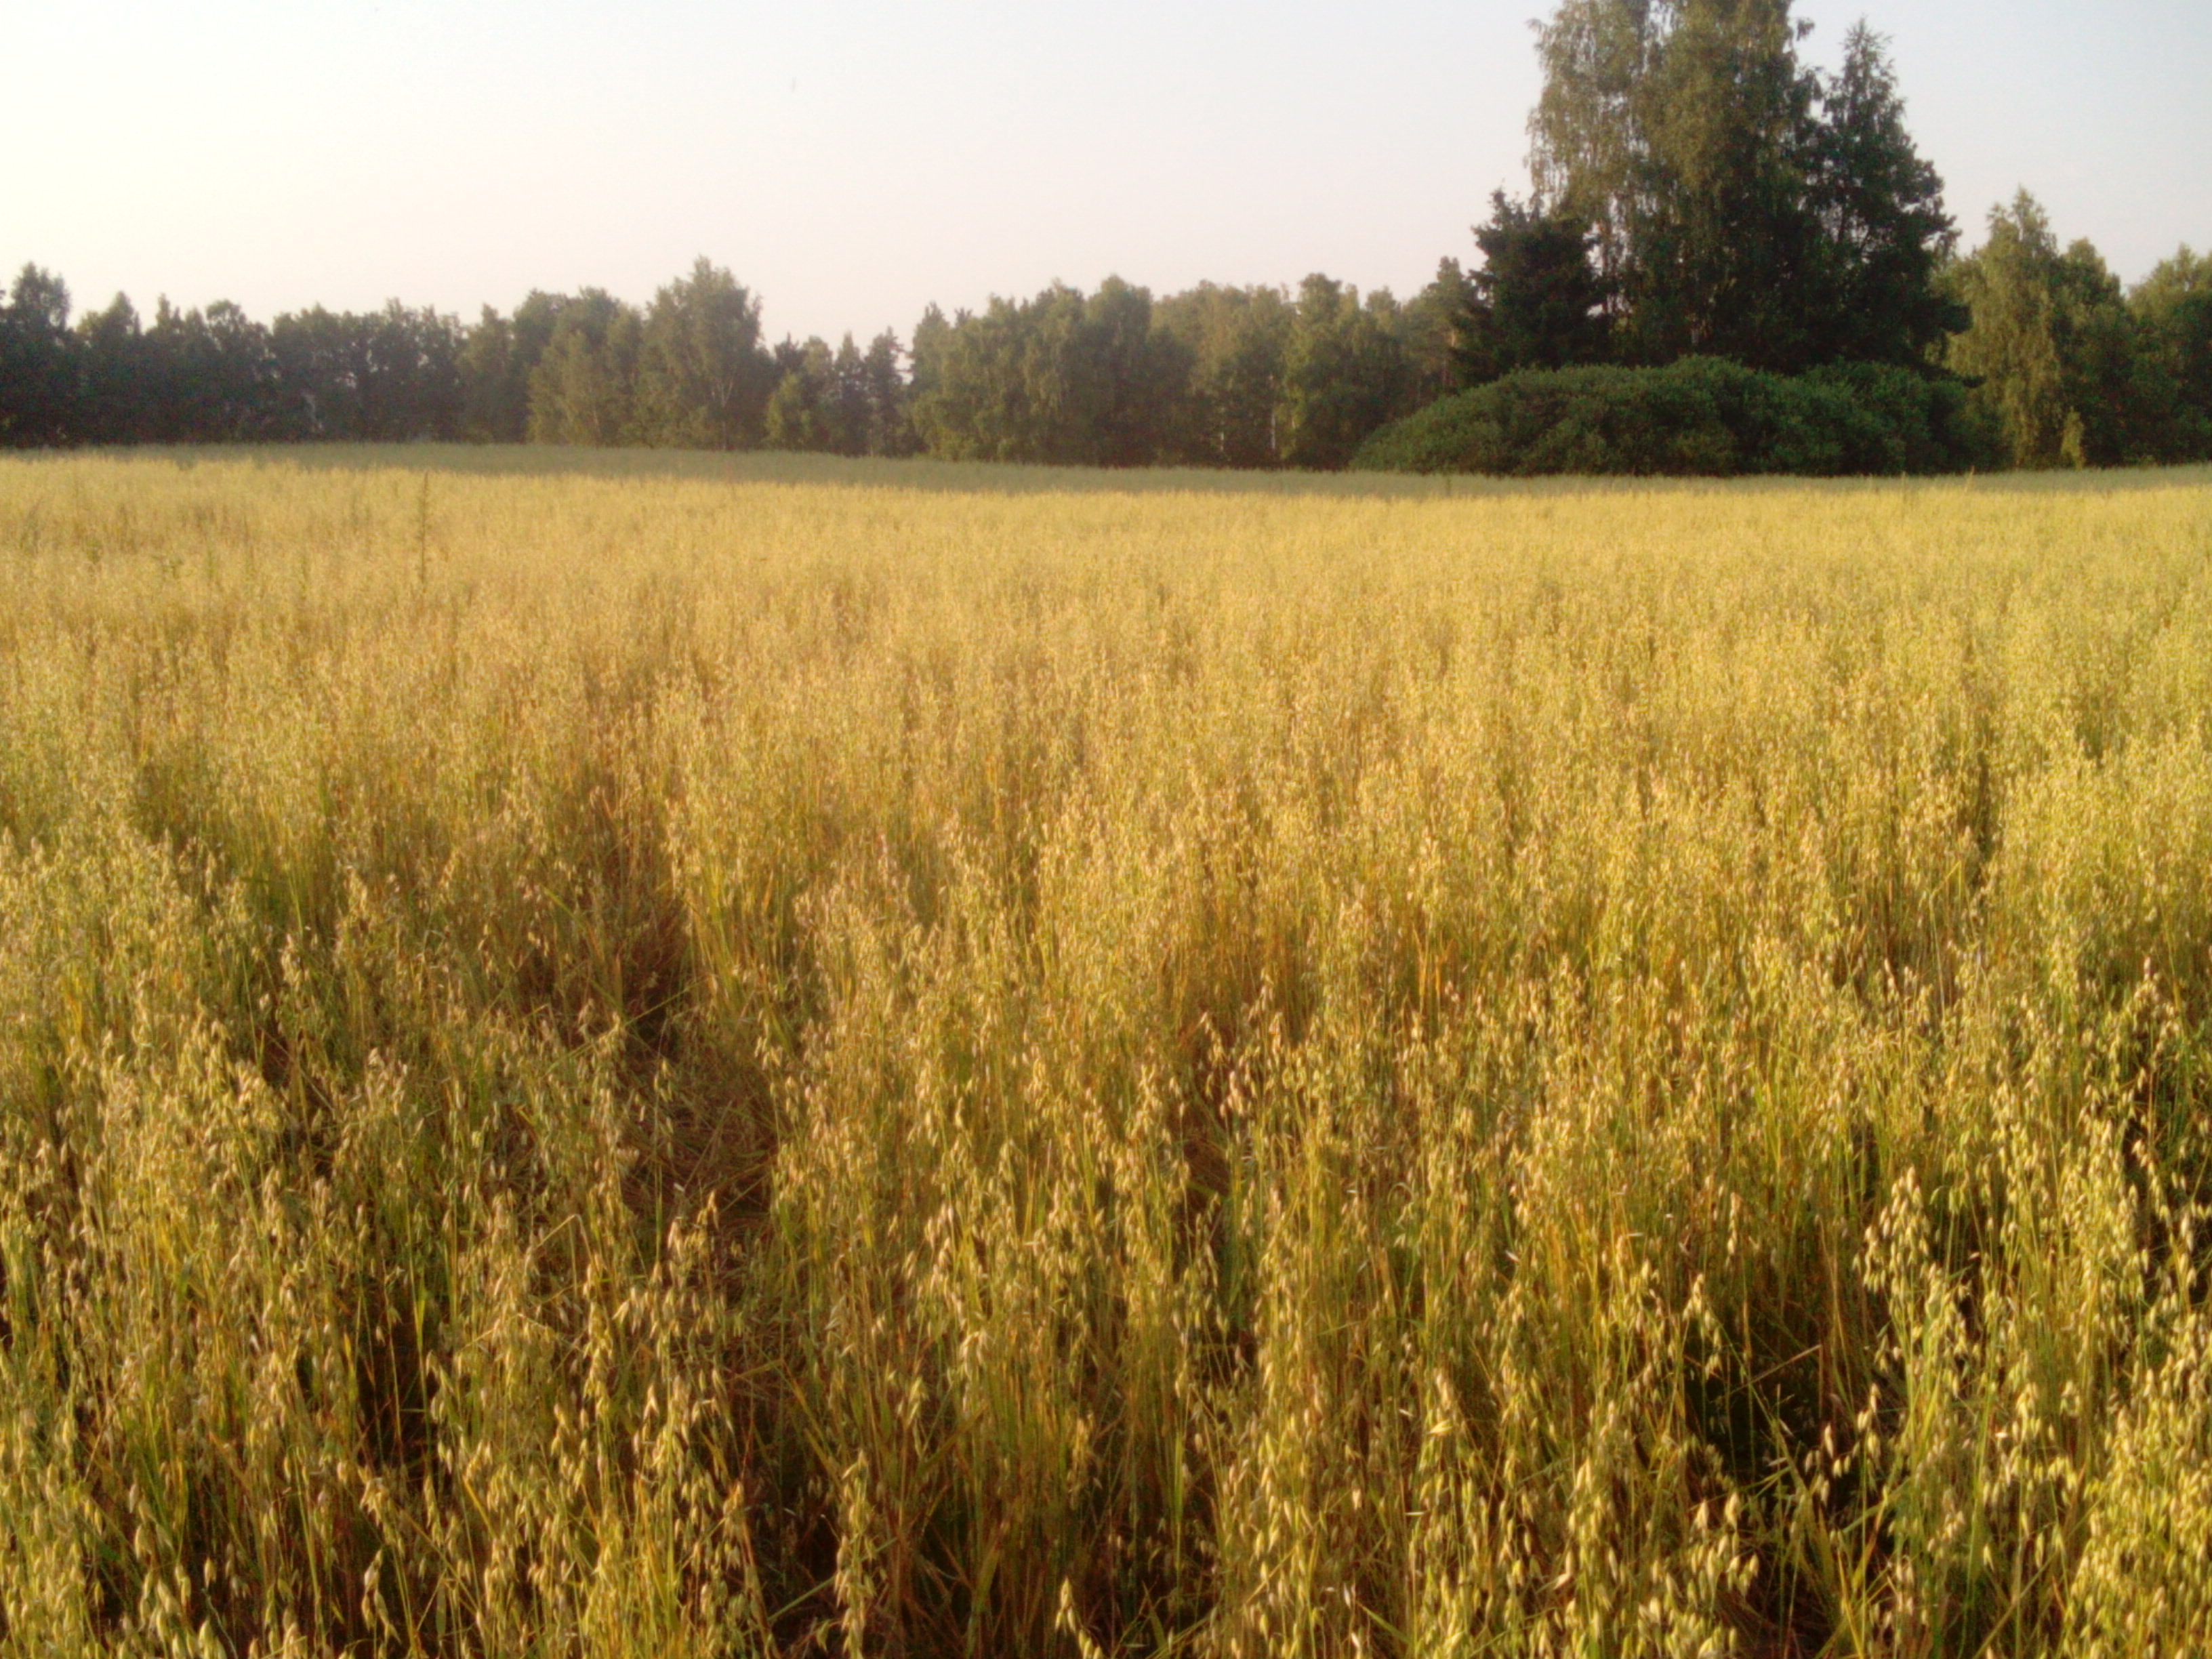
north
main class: Cropland
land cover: Oats
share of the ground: > 75 %
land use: Agriculture (excluding fallow land and kitchen gardens)
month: August
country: LV
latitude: 56.9777
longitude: 21.7082
